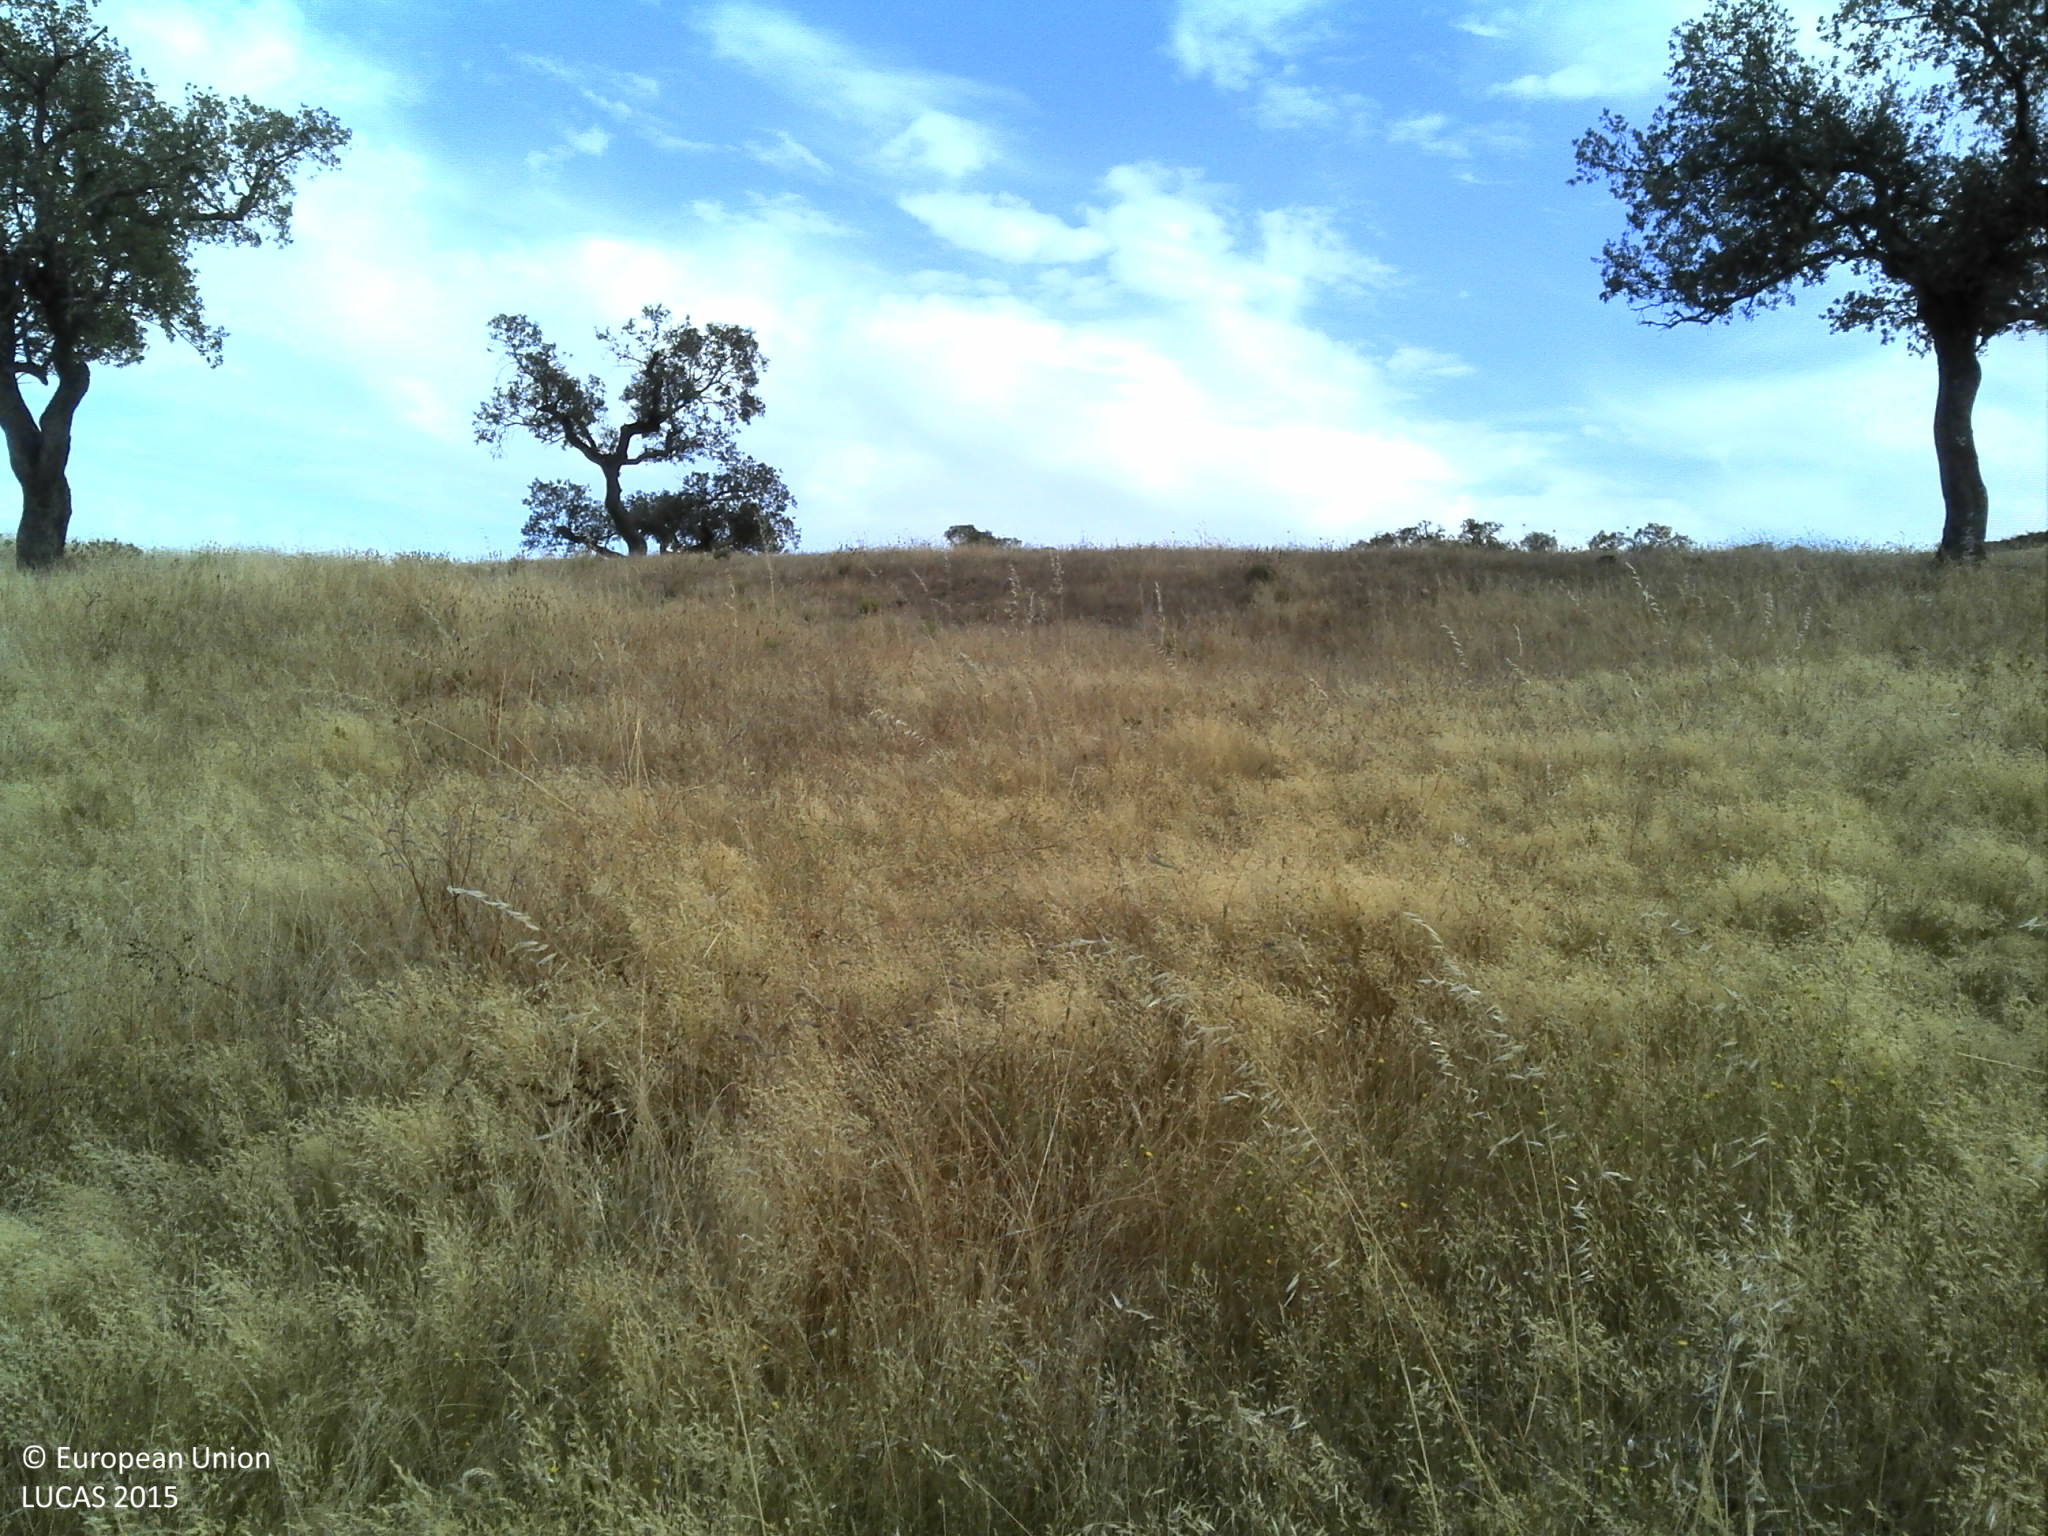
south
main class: Woodland
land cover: Broadleaved woodland
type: broadleaved evergreen forest
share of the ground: 10 - 25 %
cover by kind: unconsolidated bare surface 45 %, broadleaved forest trees 25 %, herbaceous plants 25 %
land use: Forestry
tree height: > 5 m
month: July
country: PT
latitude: 38.1277
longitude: -7.0902
